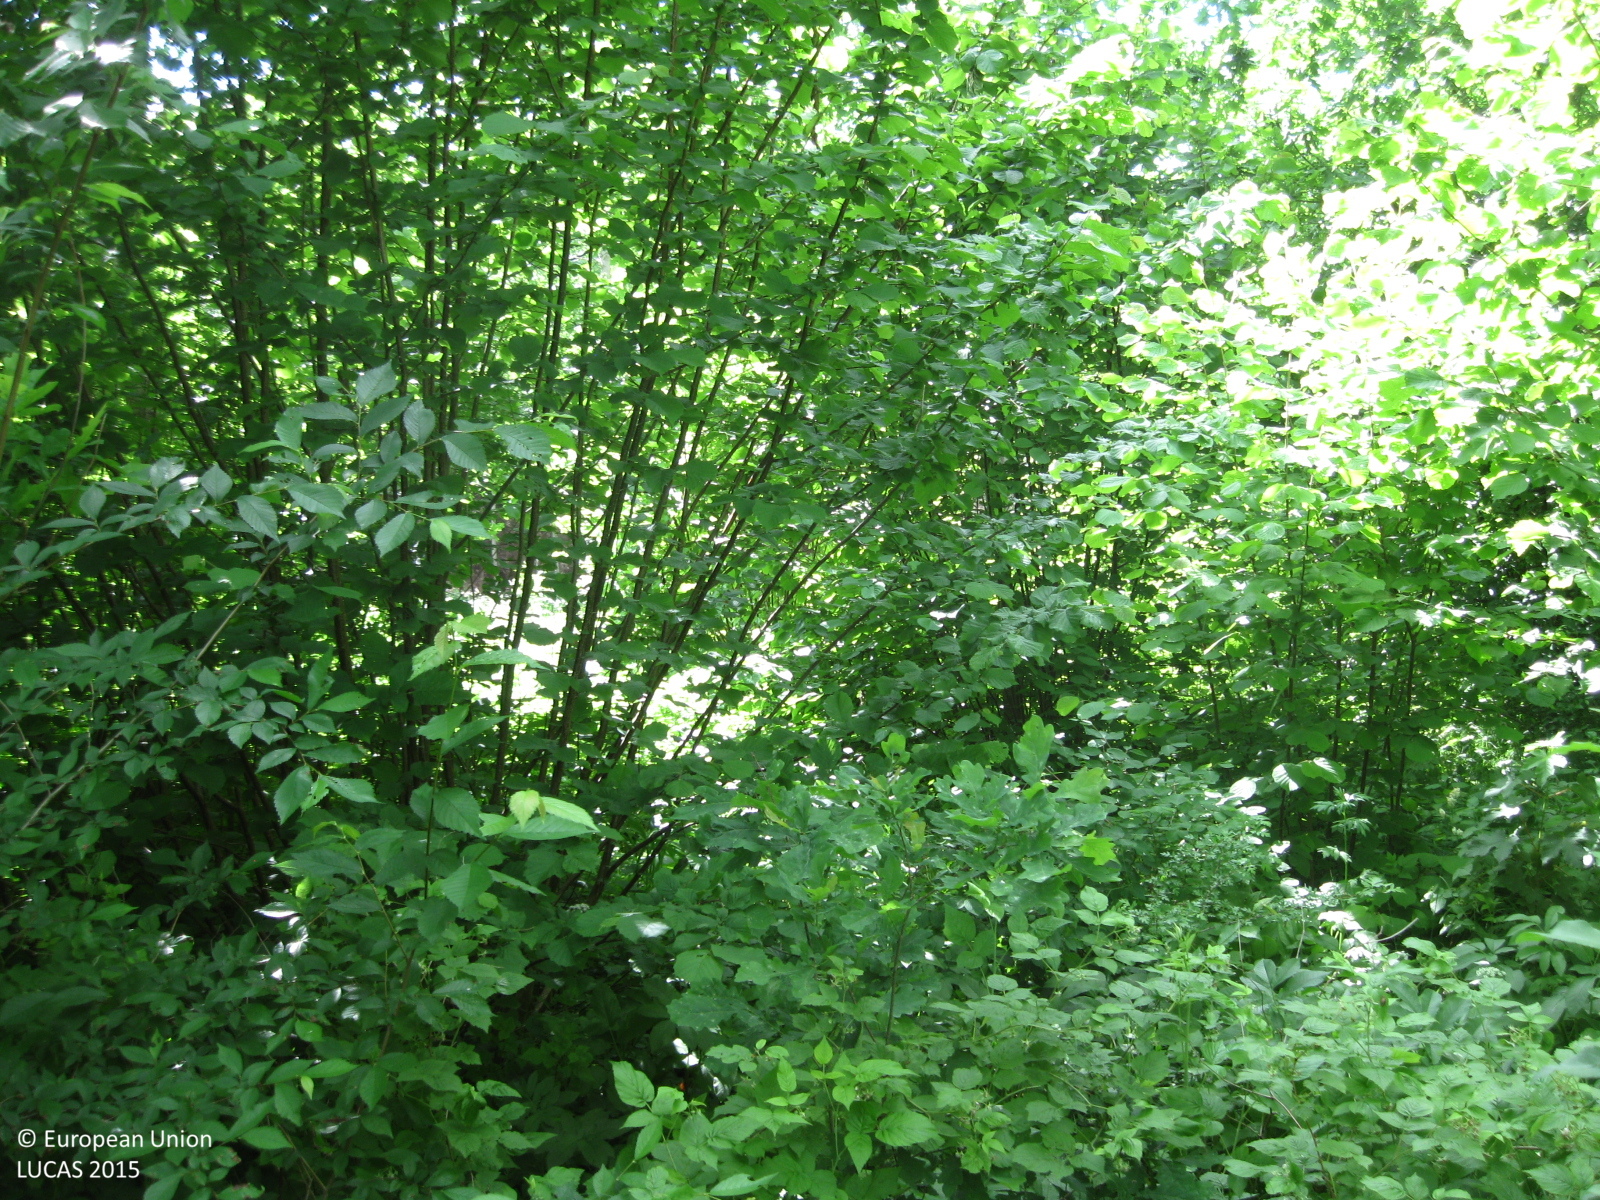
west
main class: Woodland
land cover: Broadleaved woodland
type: non-riverine alder, birch or aspen forest
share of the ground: 50 - 75 %
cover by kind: broadleaved forest trees 70 %, shrubs 15 %, herbaceous plants 15 %
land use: Forestry
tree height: > 5 m
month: June
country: LT
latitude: 55.3788
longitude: 23.8324
